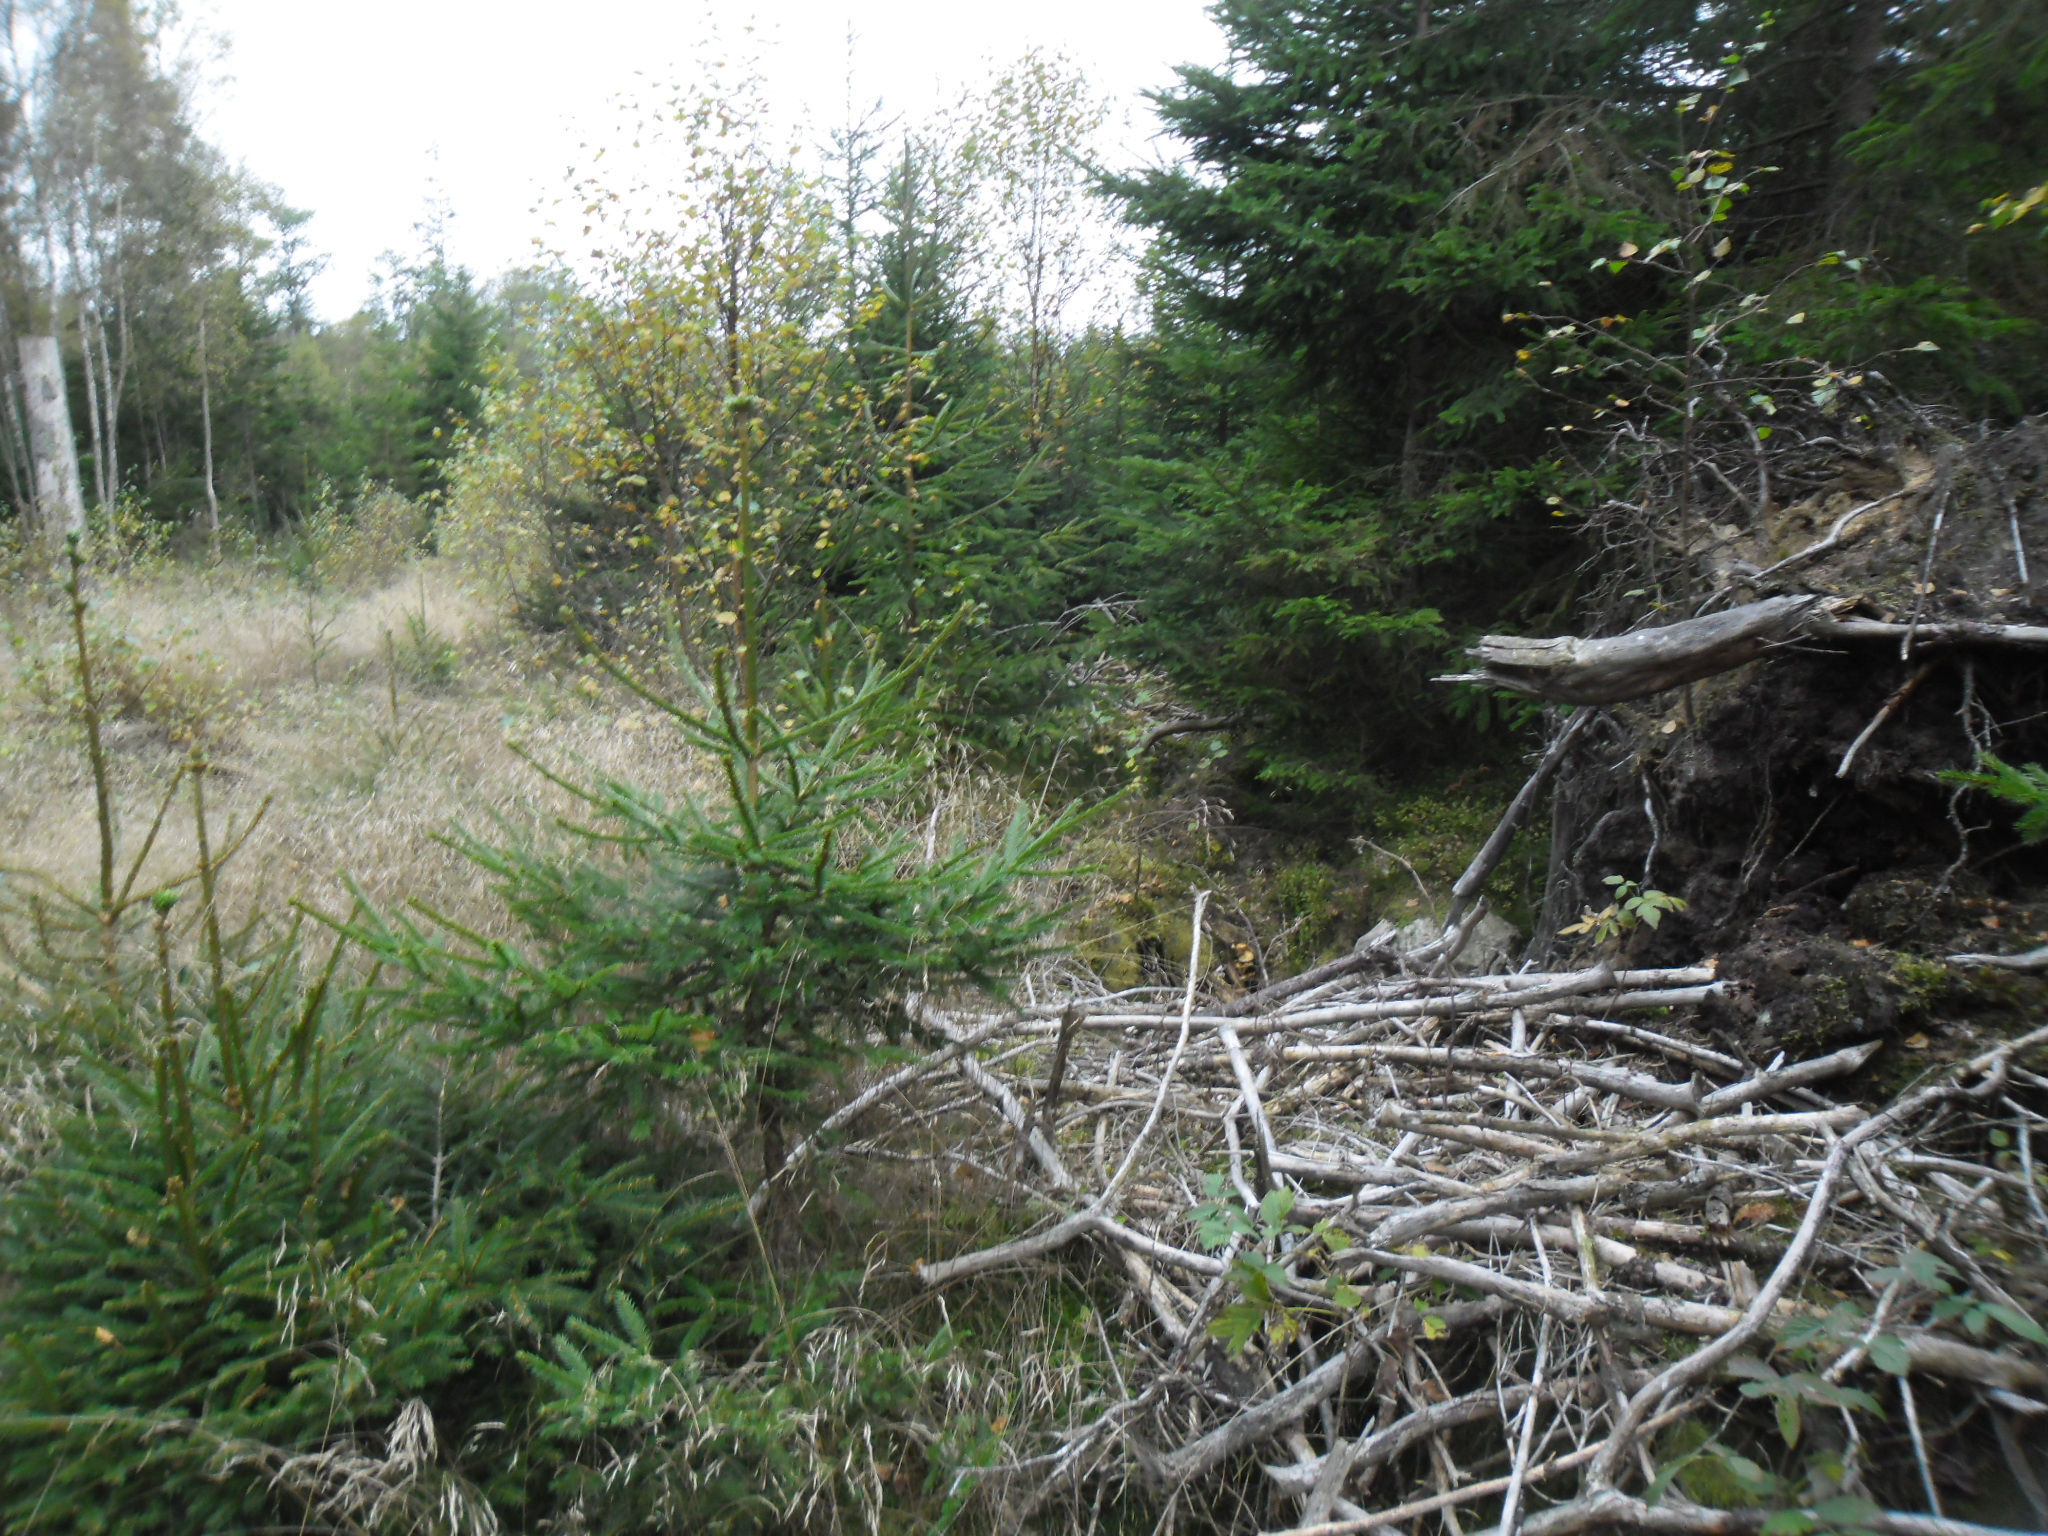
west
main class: Woodland
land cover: Spruce dominated coniferous woodland
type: boreal forest
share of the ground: > 75 %
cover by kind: coniferous forest trees 100 %
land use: Forestry
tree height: > 5 m
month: October
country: SE
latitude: 56.3674
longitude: 13.7368
